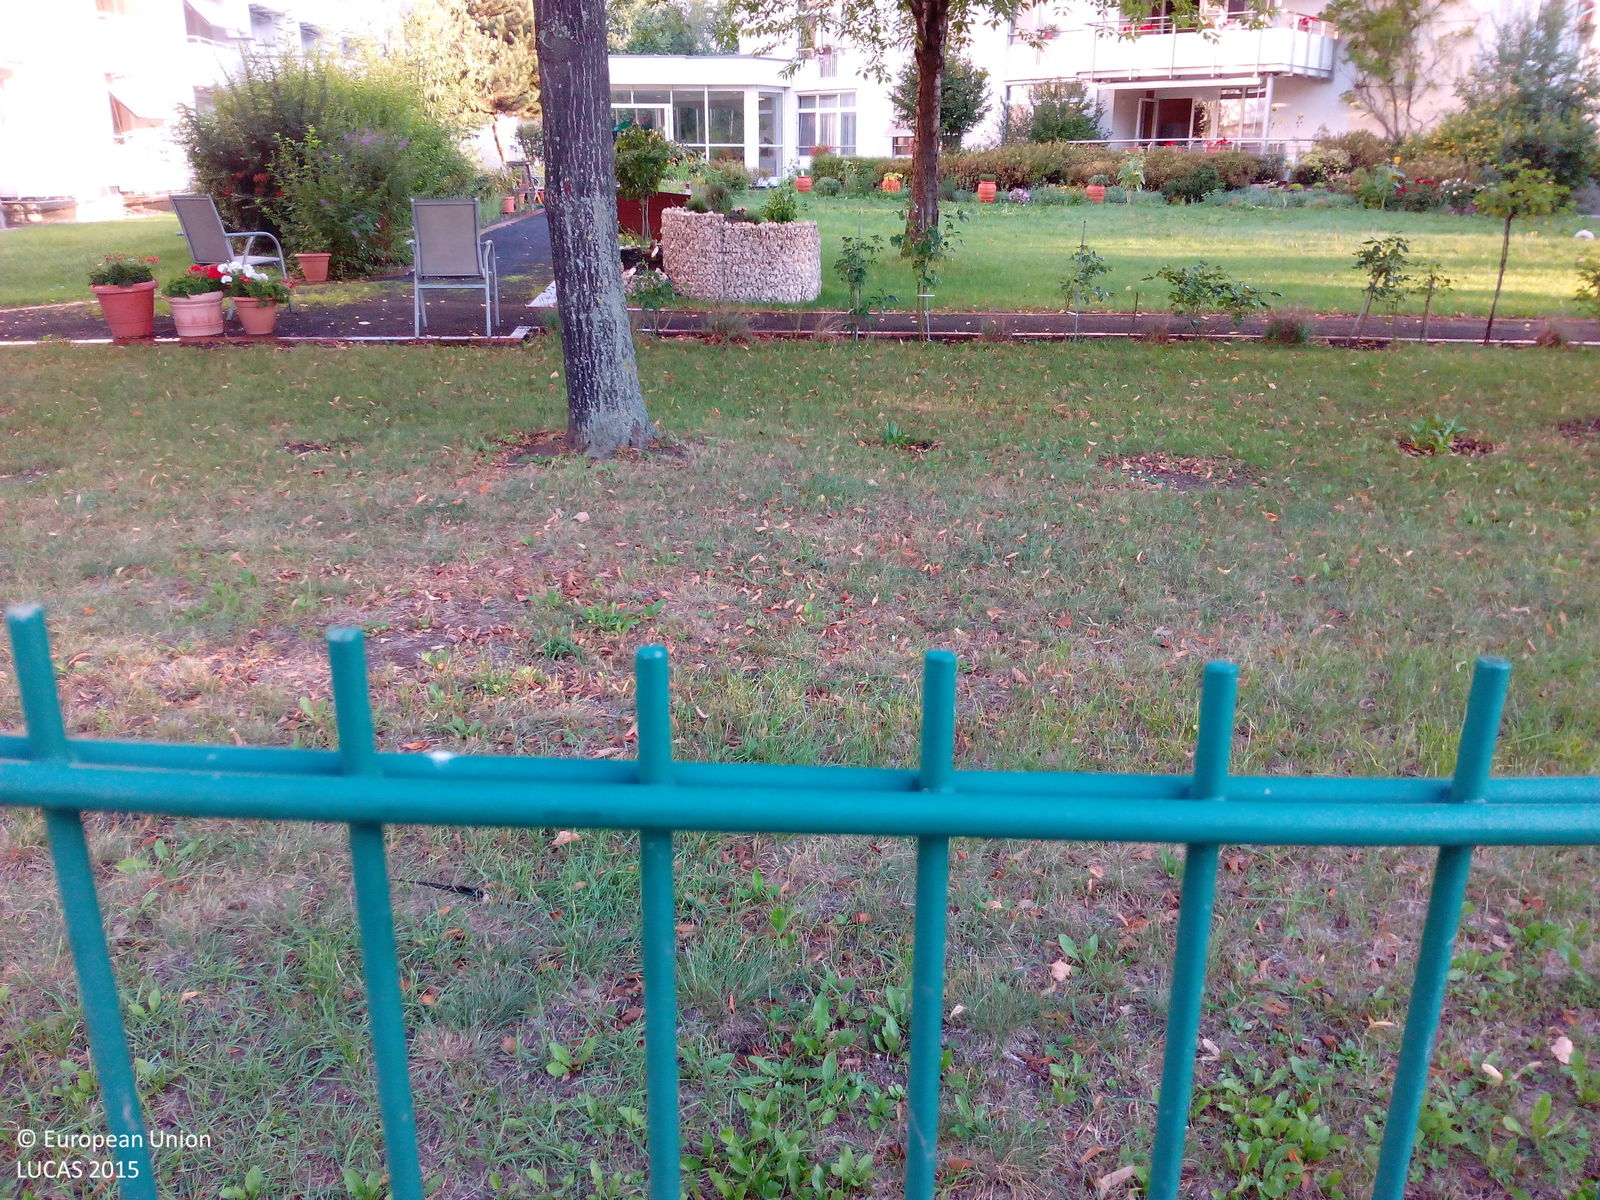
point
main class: Woodland
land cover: Broadleaved woodland
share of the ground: 25 - 50 %
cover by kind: herbaceous plants 45 %, broadleaved forest trees 40 %, consolidated bare surface 10 %, shrubs 5 %
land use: Residential
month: August
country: DE
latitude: 51.0069
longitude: 11.0116
